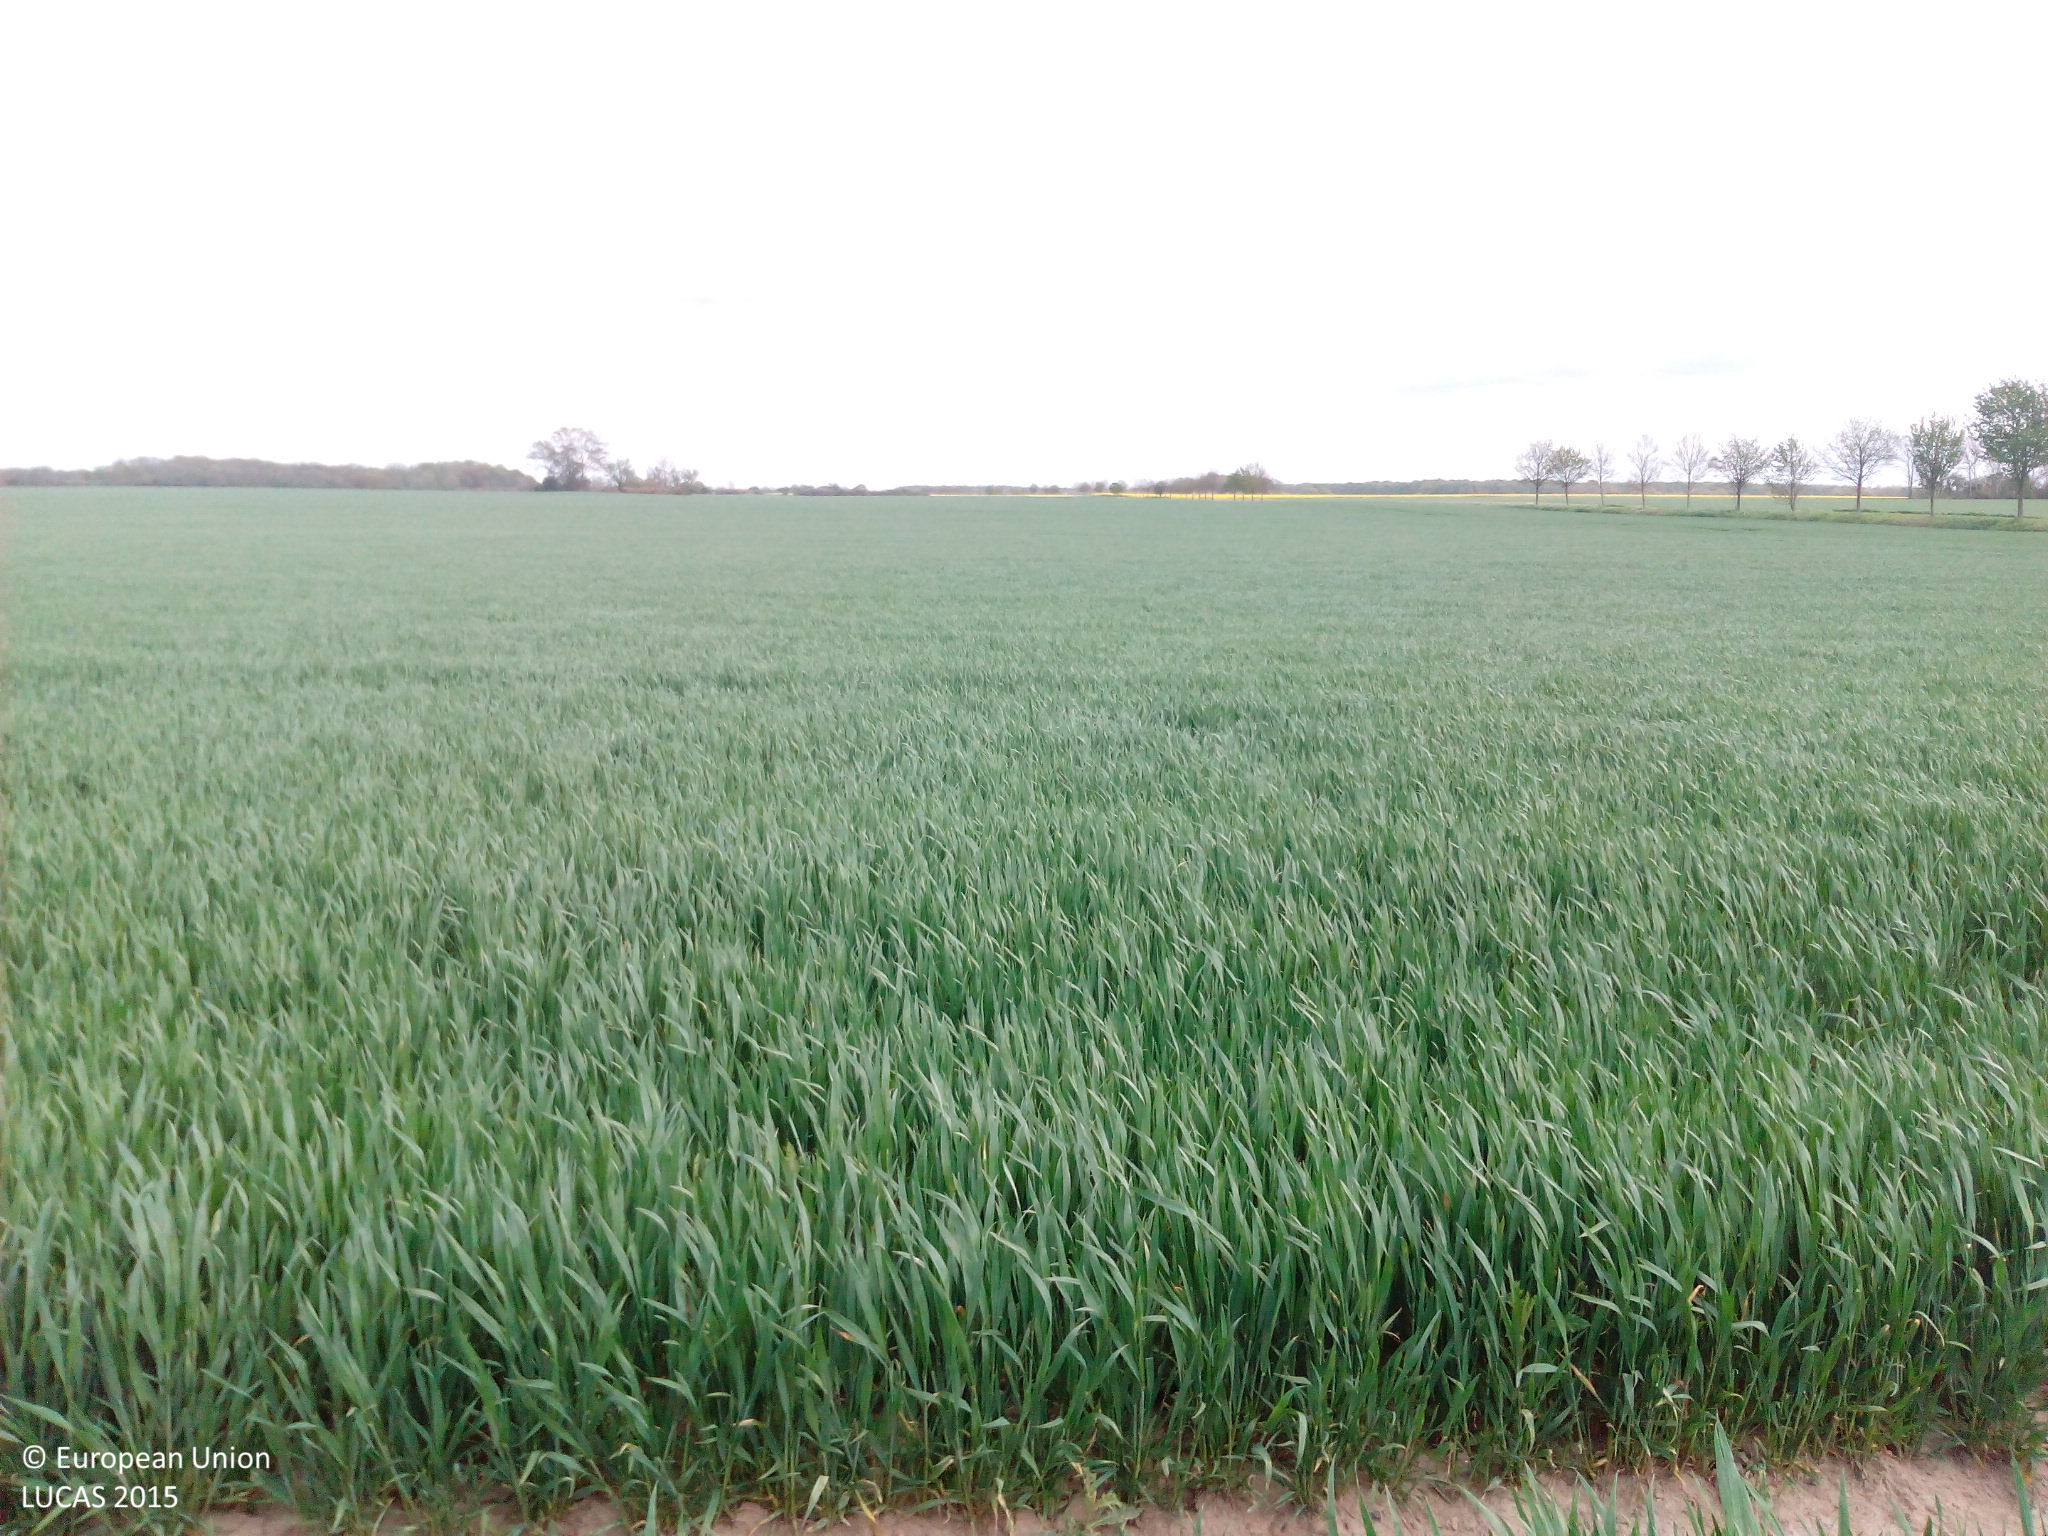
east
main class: Cropland
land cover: Common wheat
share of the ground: > 75 %
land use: Agriculture (excluding fallow land and kitchen gardens)
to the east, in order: Common wheat
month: May
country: DE
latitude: 54.3085
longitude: 12.6272
